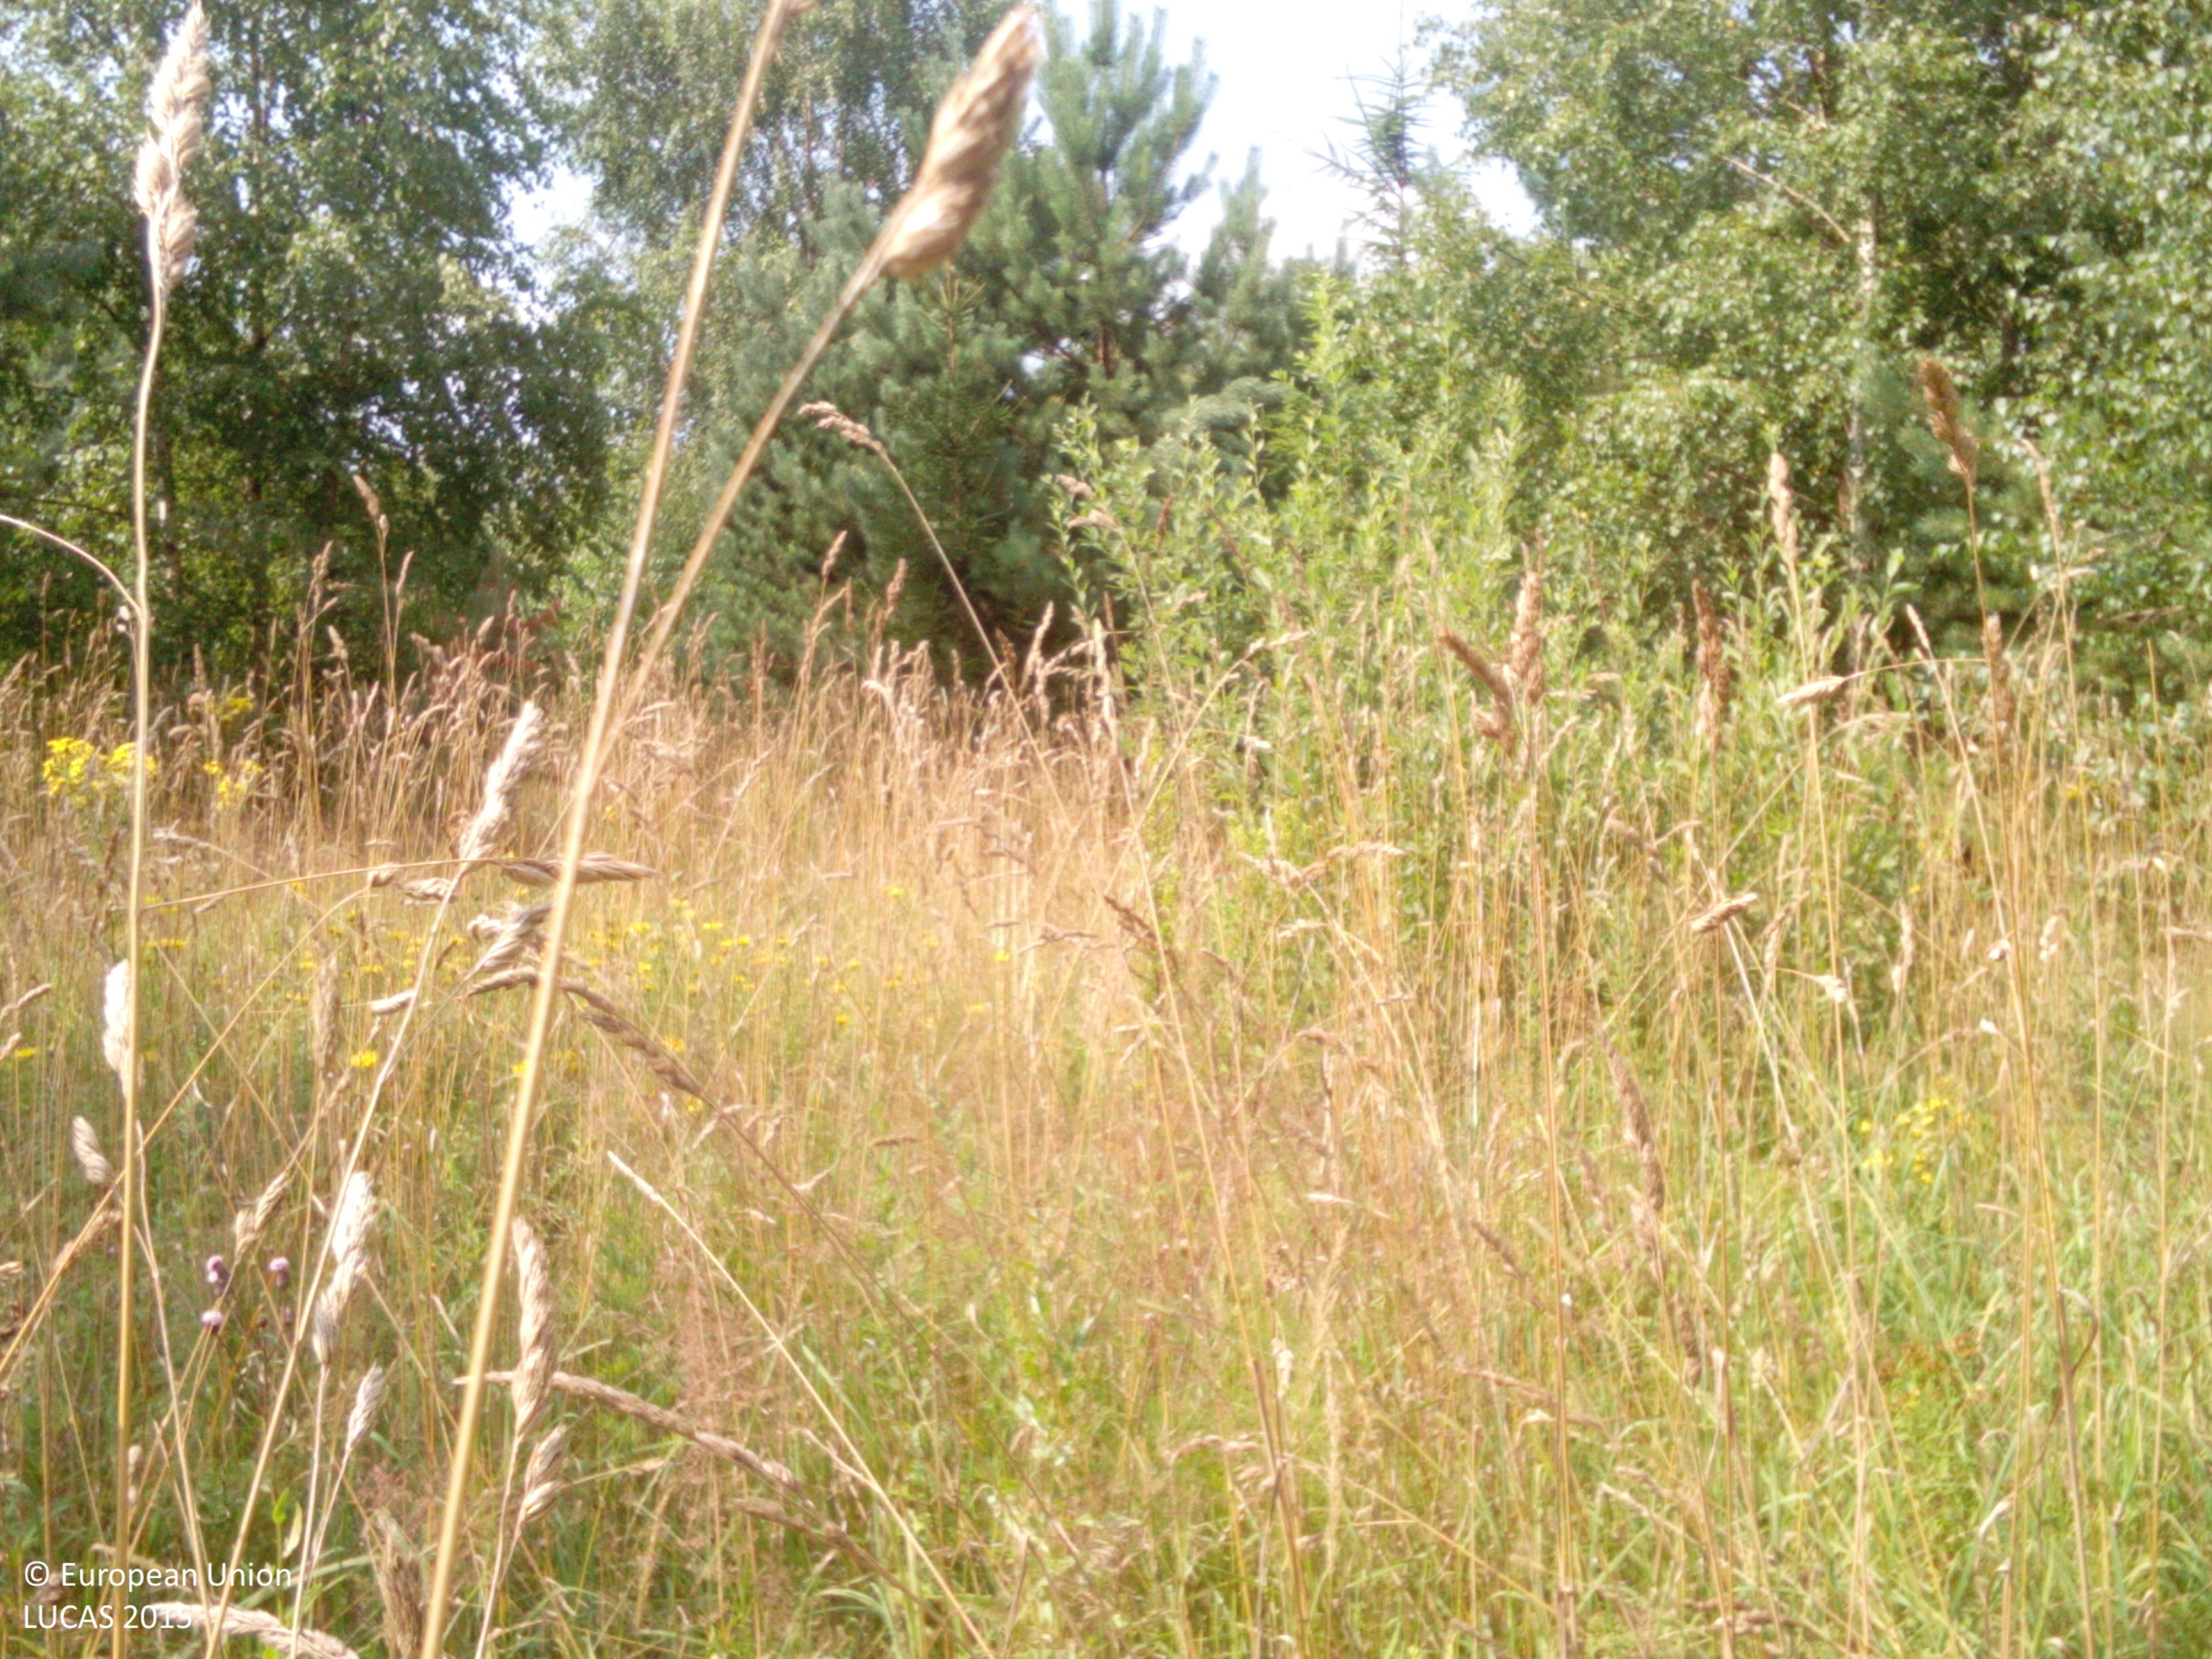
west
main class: Woodland
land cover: Pine dominated mixed woodland
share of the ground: 50 - 75 %
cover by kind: herbaceous plants 50 %, coniferous forest trees 25 %, broadleaved forest trees 25 %
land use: Forestry
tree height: > 5 m
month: August
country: LV
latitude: 56.9364
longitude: 21.7620
